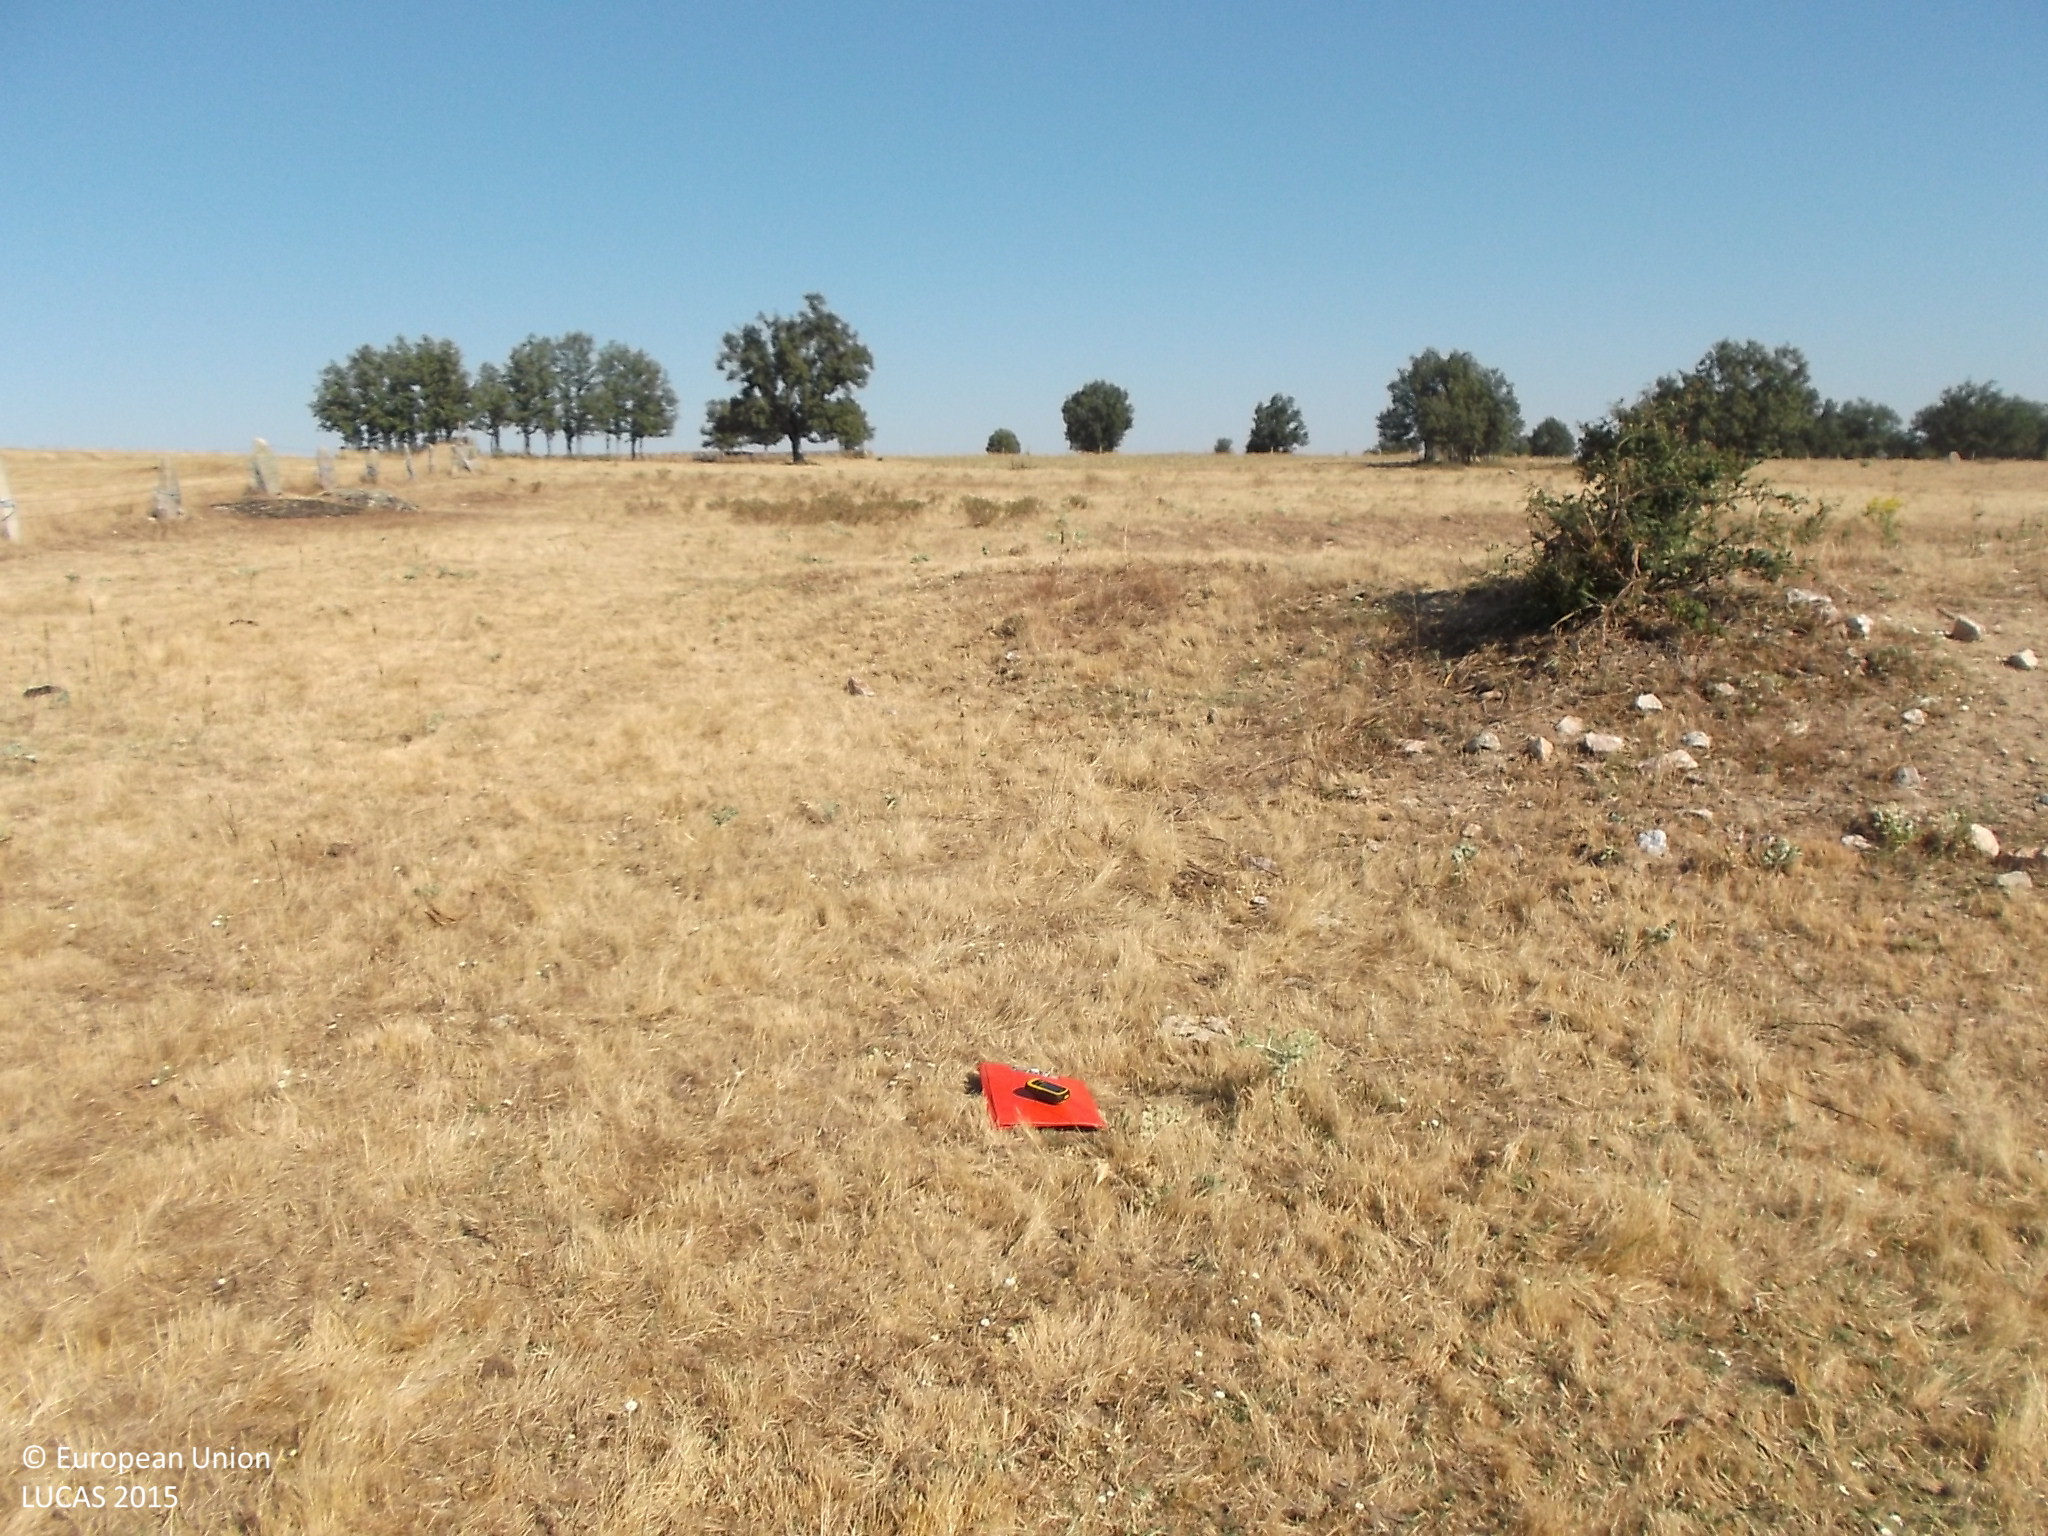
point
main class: Grassland
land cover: Grassland without tree/shrub cover
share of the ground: > 75 %
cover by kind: herbaceous plants 100 %
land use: Agriculture (excluding fallow land and kitchen gardens)
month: July
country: ES
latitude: 41.3014
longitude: -5.9848
